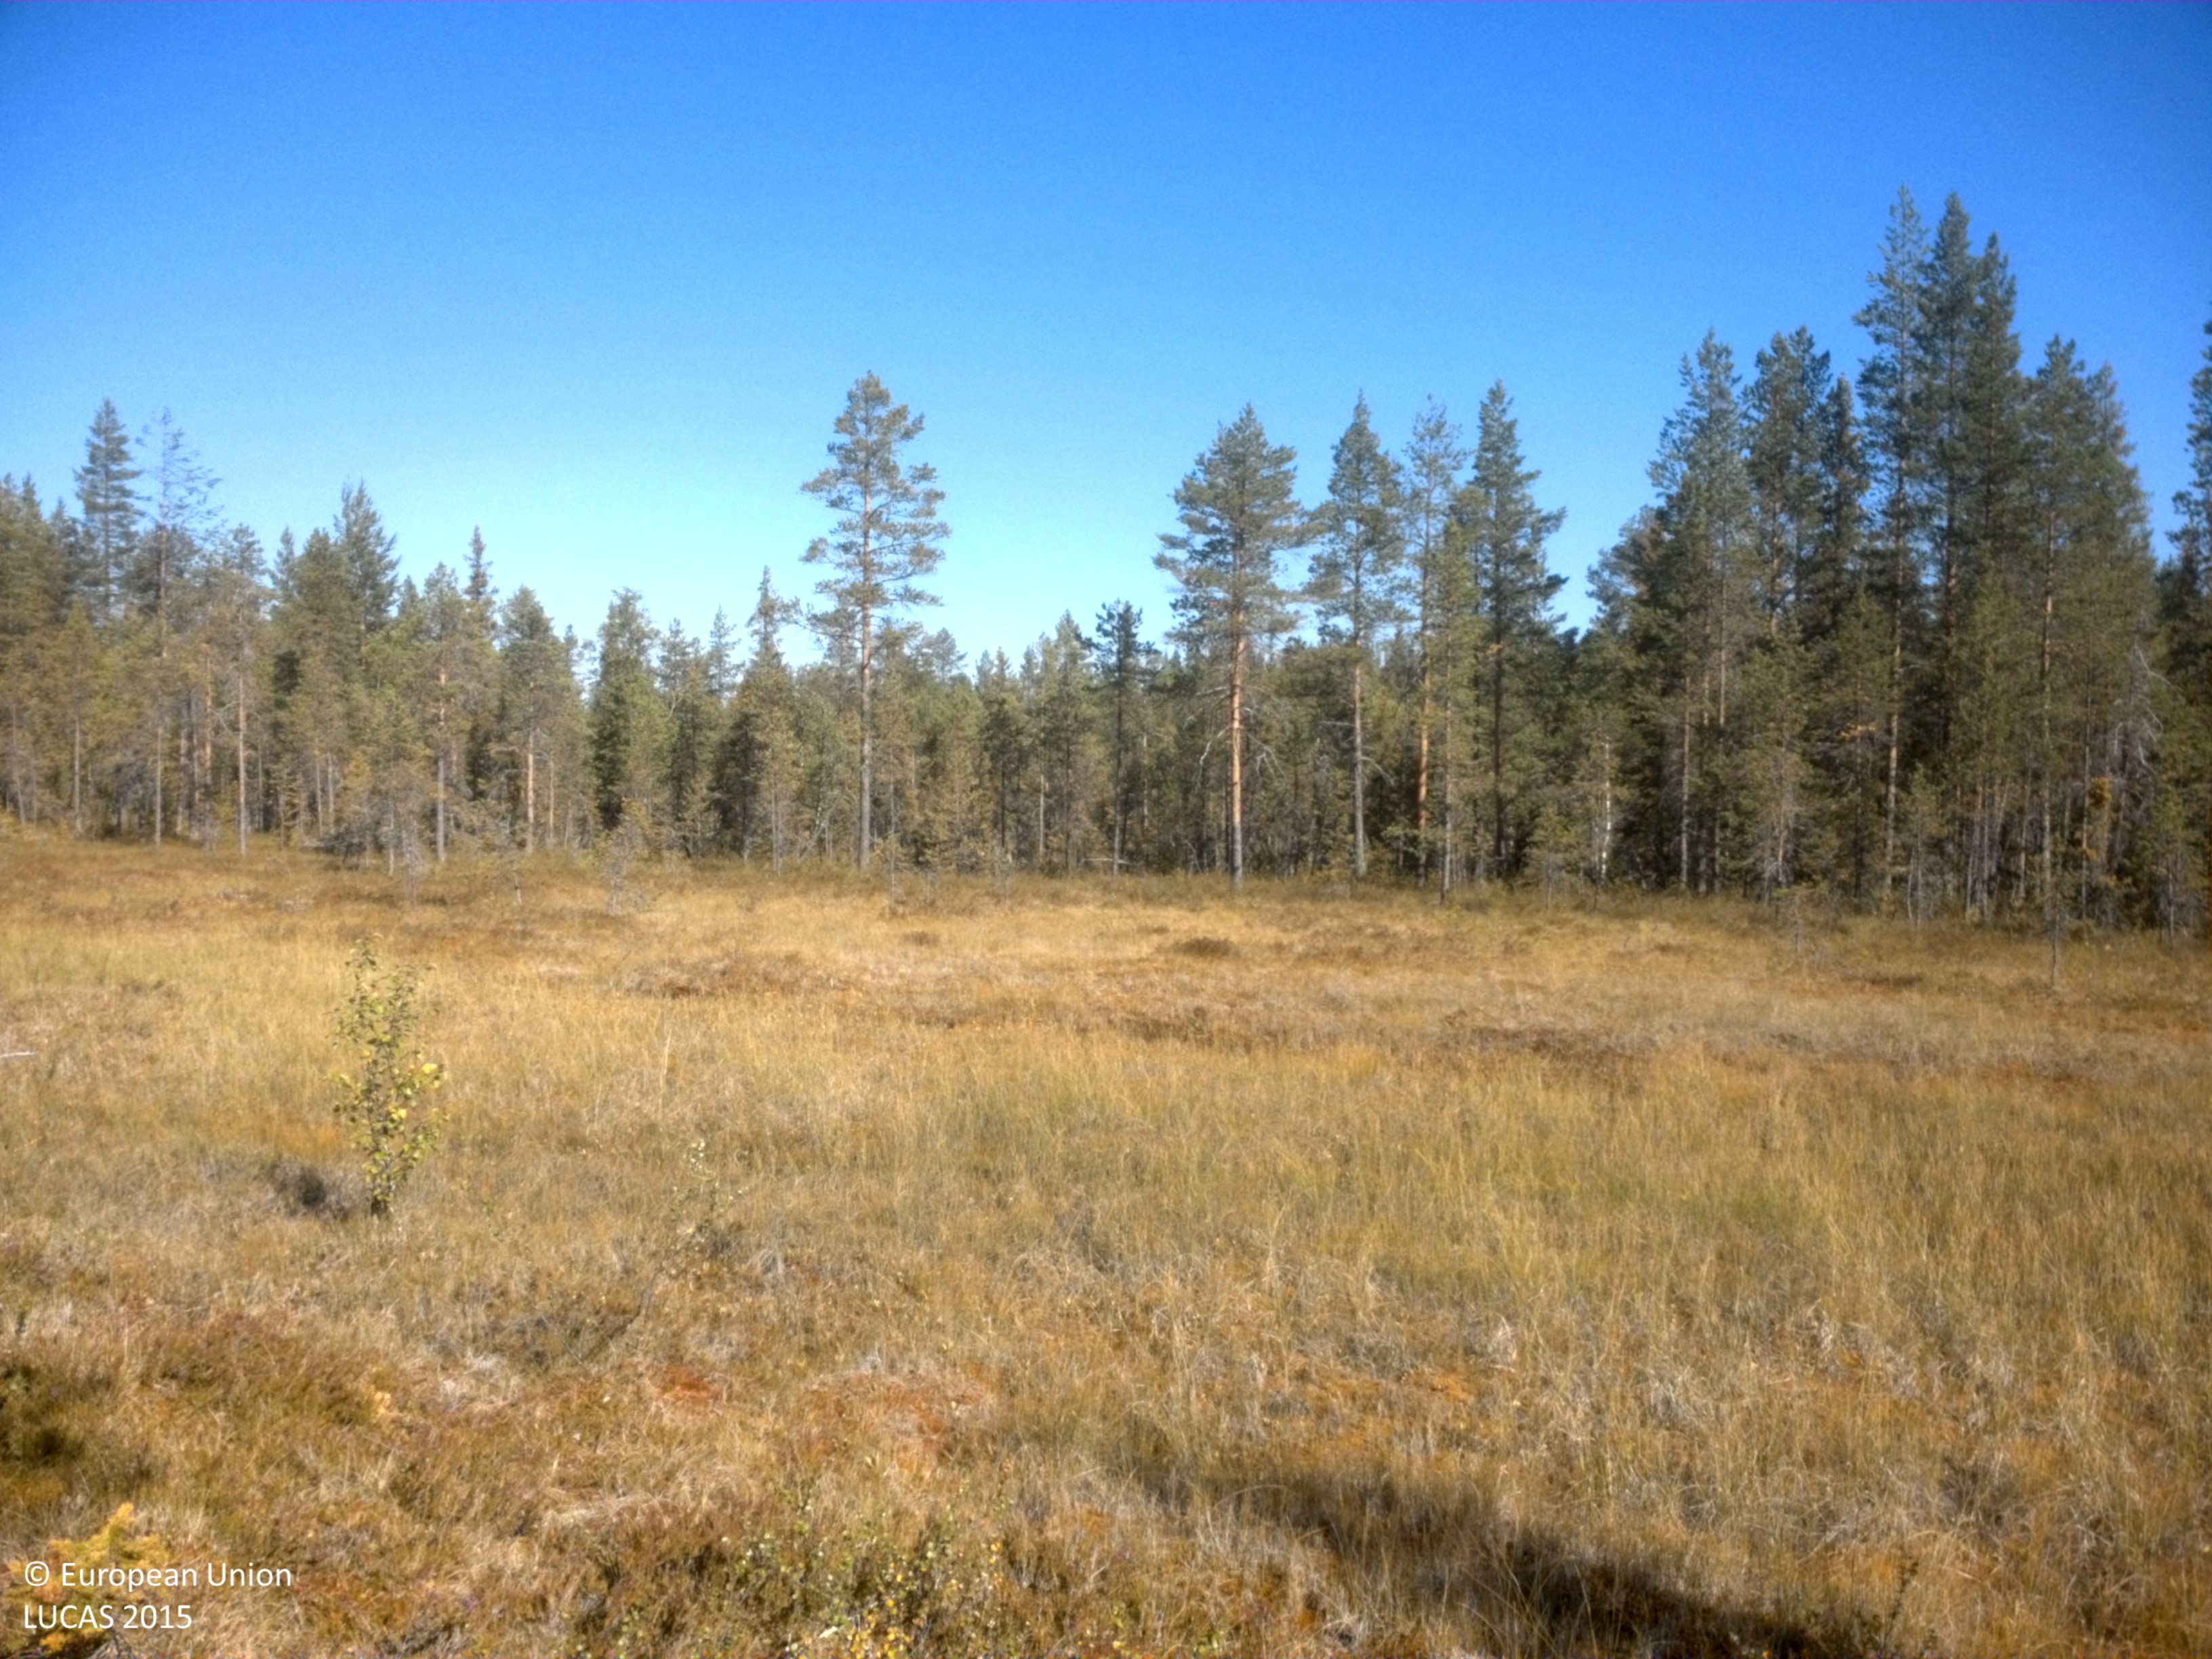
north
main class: Woodland
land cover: Pine dominated mixed woodland
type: boreal forest
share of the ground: 50 - 75 %
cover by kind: coniferous forest trees 45 %, shrubs 20 %, lichens and mosses 20 %, broadleaved forest trees 15 %
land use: Forestry
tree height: > 5 m
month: August
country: SE
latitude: 64.7152
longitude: 18.8435
